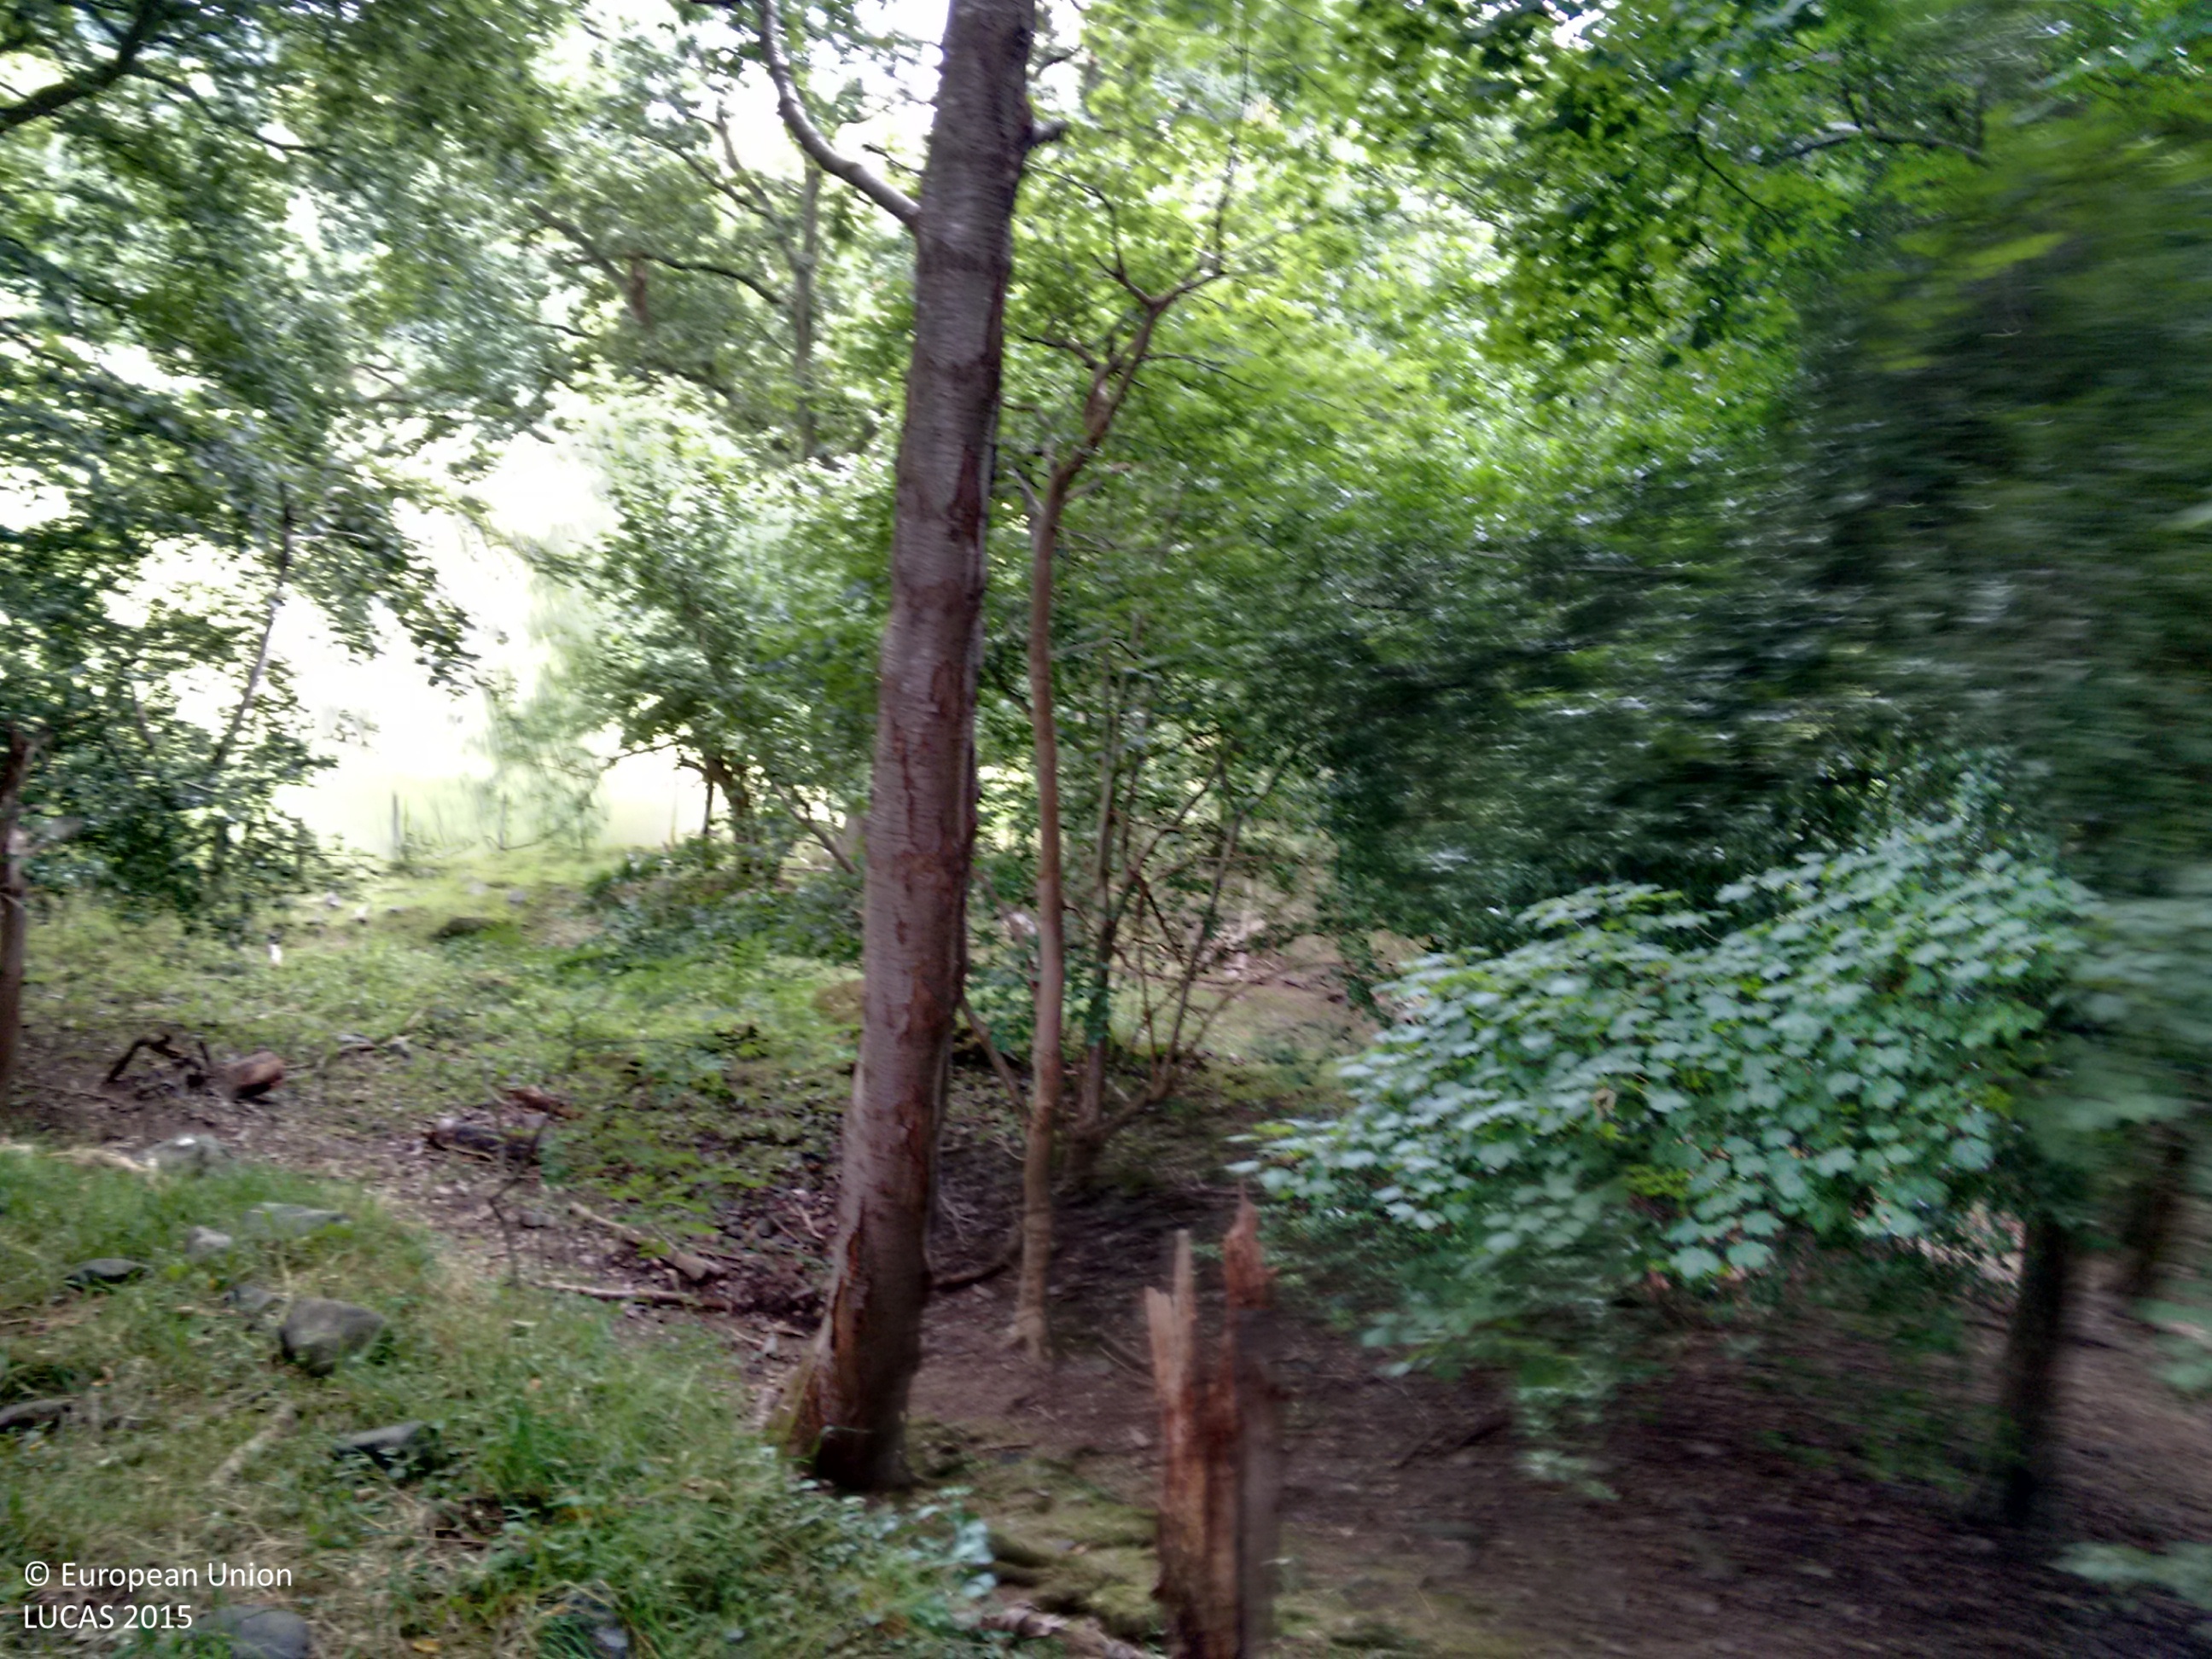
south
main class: Woodland
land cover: Broadleaved woodland
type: mesophytic deciduous forest
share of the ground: > 75 %
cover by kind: broadleaved forest trees 100 %
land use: Agriculture (excluding fallow land and kitchen gardens)
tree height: > 5 m
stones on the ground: 25 - 50 %
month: August
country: GB
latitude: 53.1716
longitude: -3.8085
